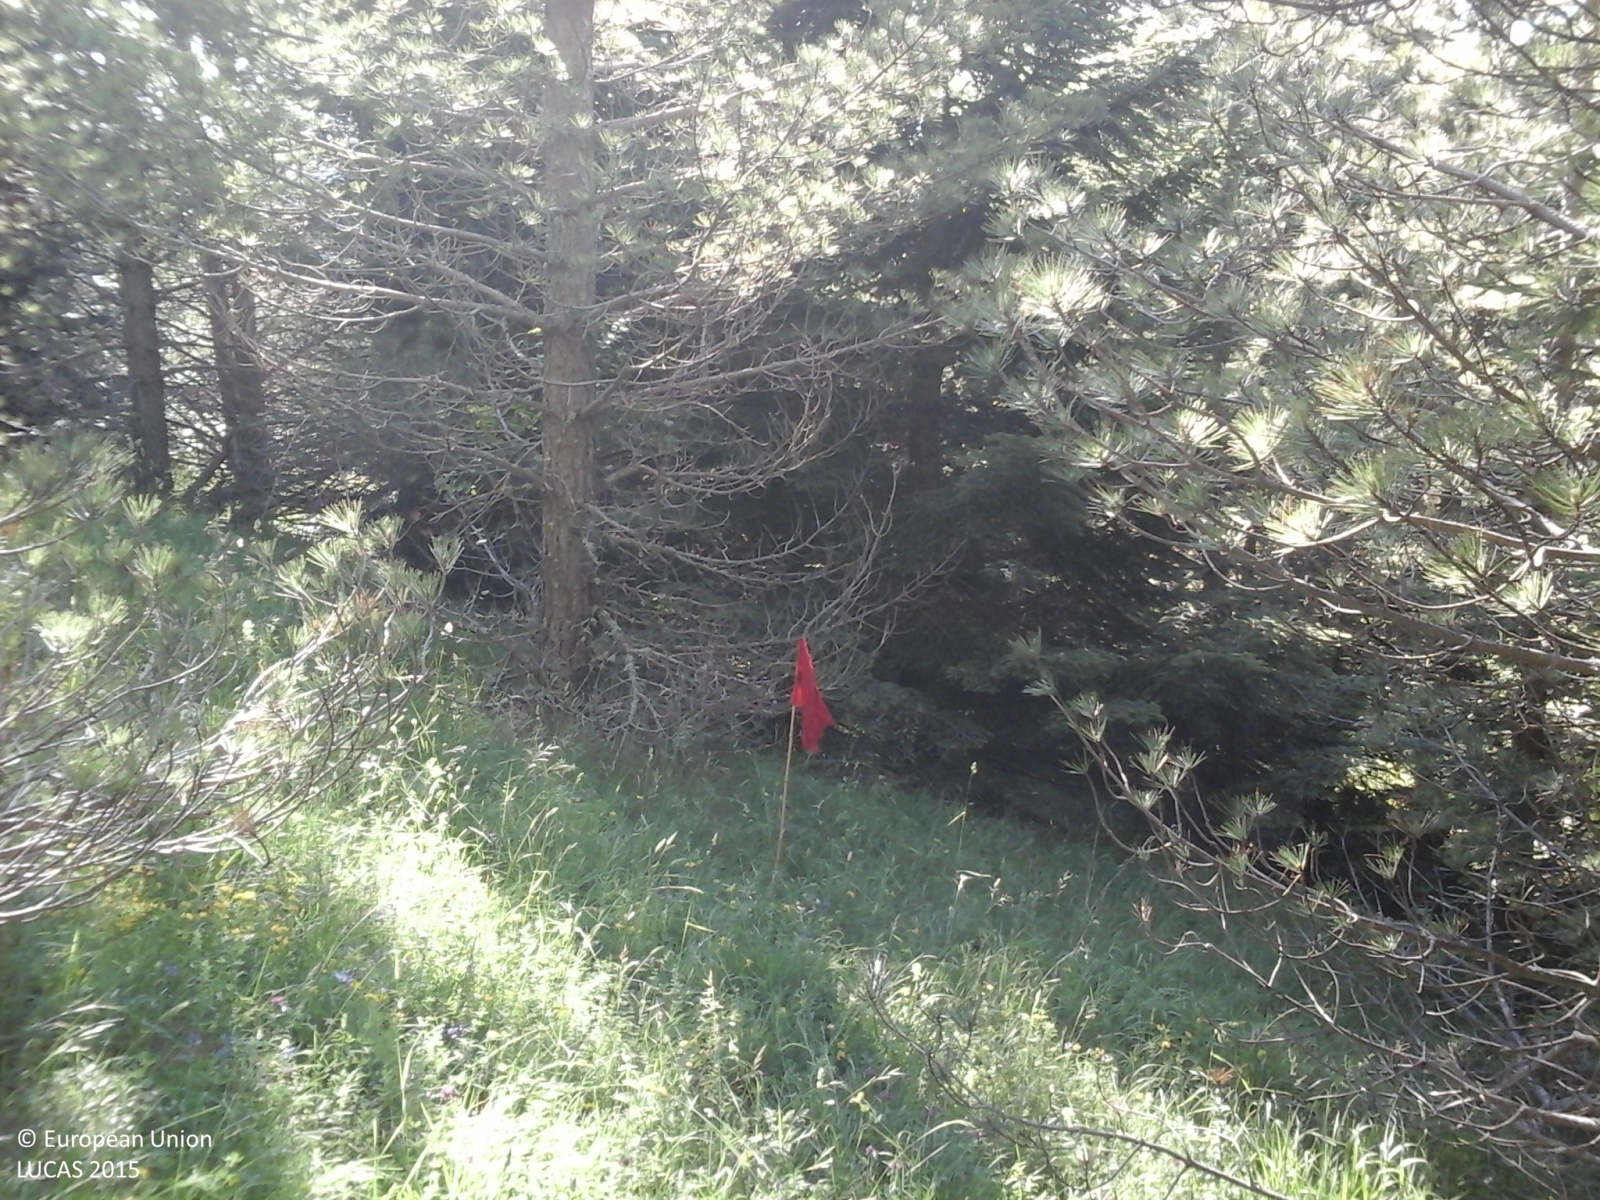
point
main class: Woodland
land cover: Other coniferous woodland
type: coniferous forest of the mediterranean region
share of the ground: > 75 %
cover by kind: coniferous forest trees 95 %, herbaceous plants 5 %
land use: Forestry
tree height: > 5 m
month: June
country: IT
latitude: 42.7480
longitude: 13.2035
